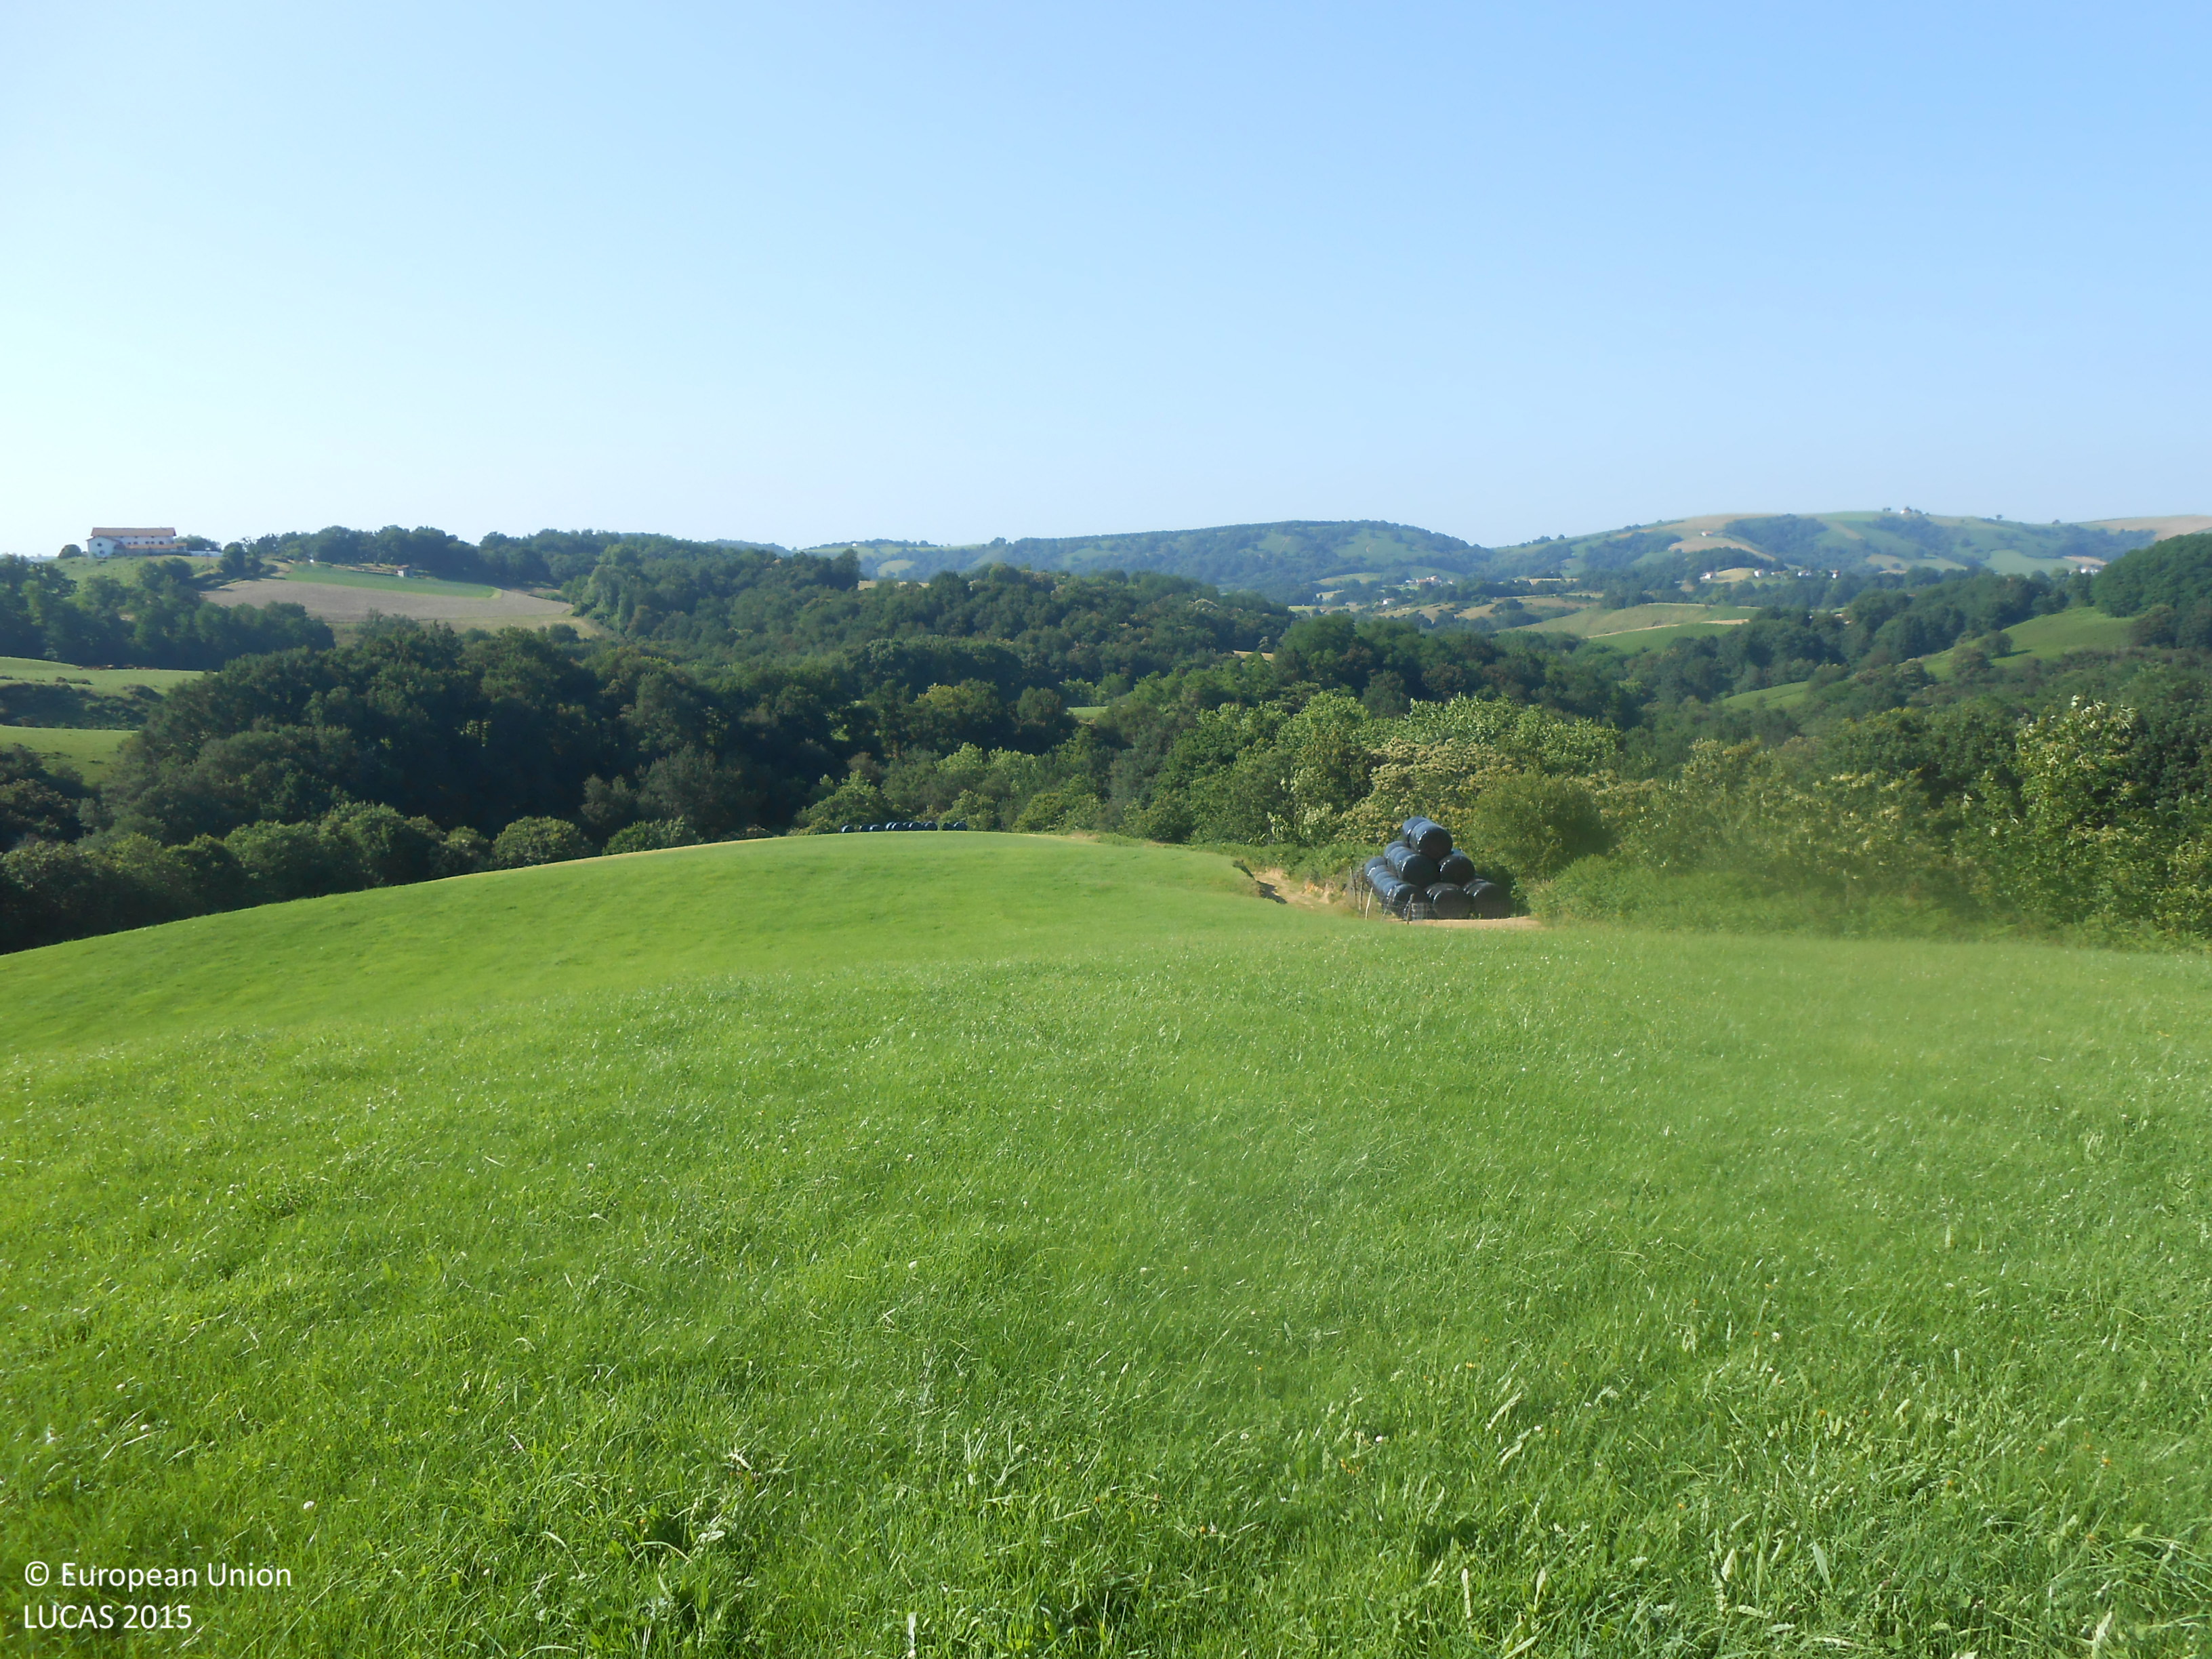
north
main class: Grassland
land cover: Grassland without tree/shrub cover
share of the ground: > 75 %
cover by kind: herbaceous plants 100 %
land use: Agriculture (excluding fallow land and kitchen gardens)
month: June
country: ES
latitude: 43.2884
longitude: -1.5159
